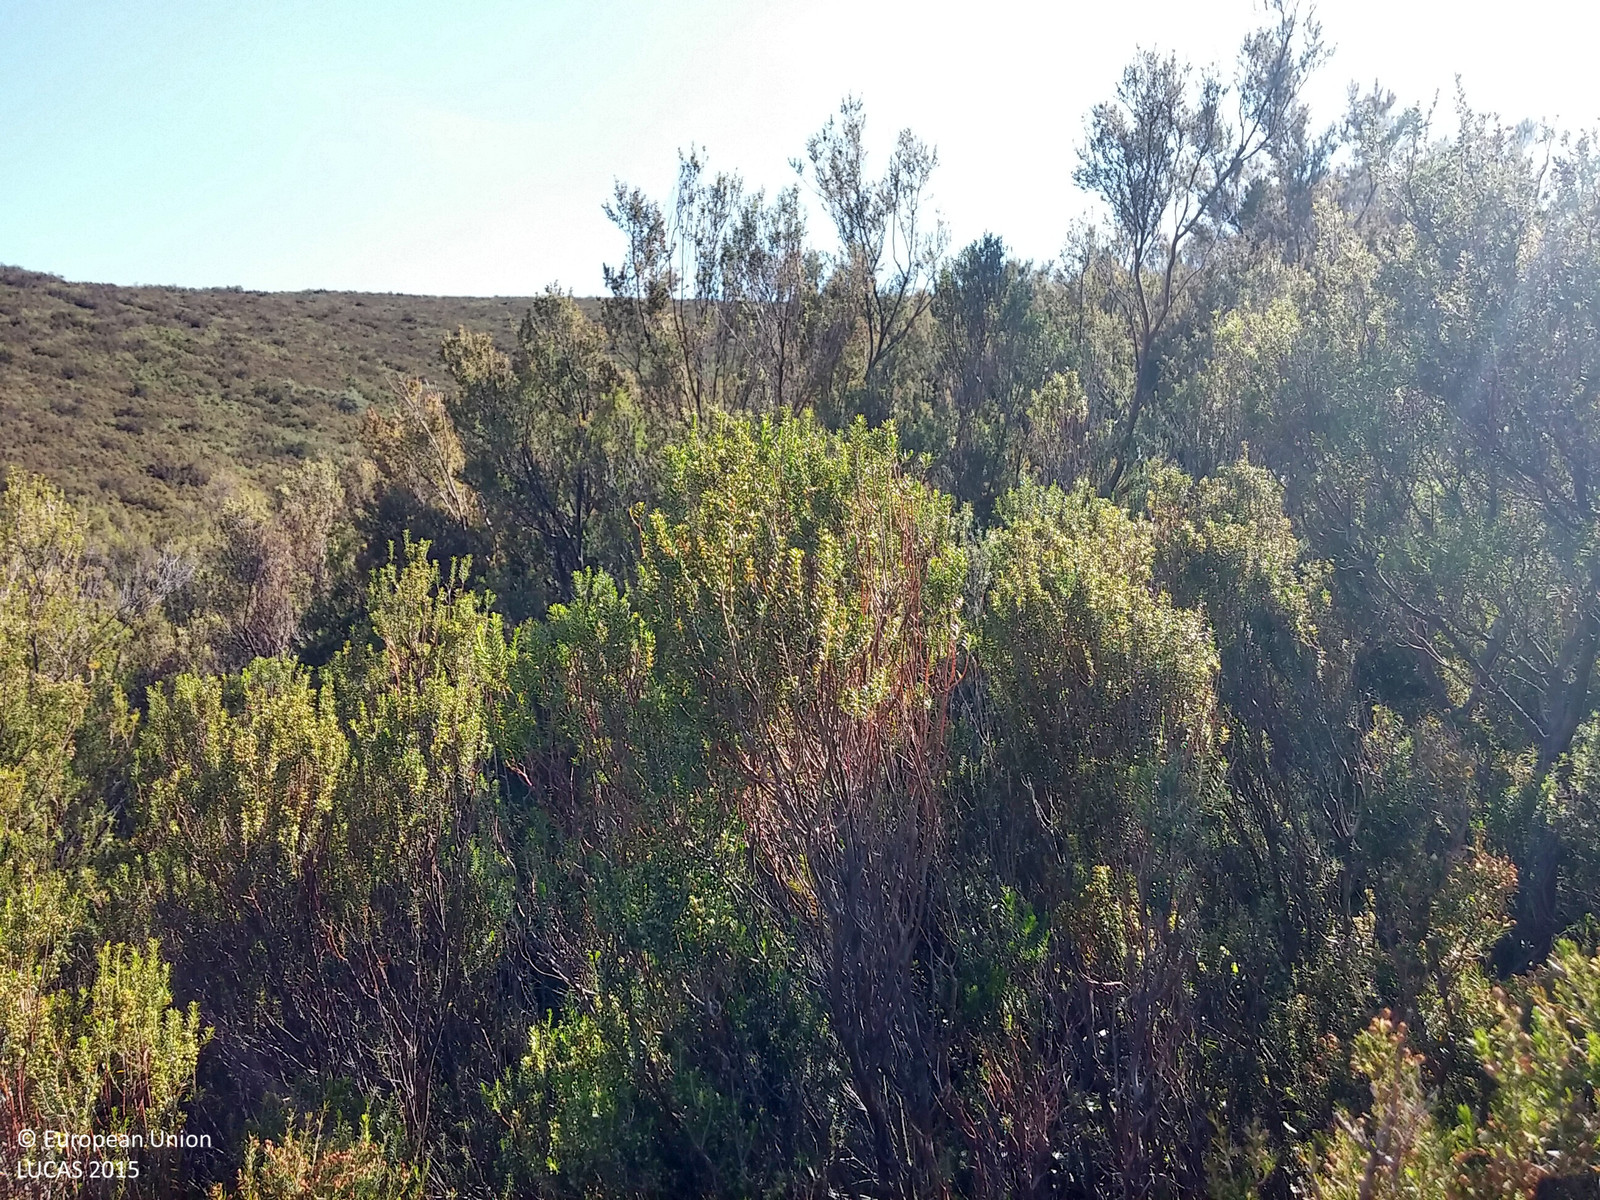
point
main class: Shrubland
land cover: Shrubland without tree cover
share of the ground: > 75 %
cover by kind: shrubs 100 %
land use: Semi-natural and natural areas not in use
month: May
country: ES
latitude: 42.4331
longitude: 3.0483
